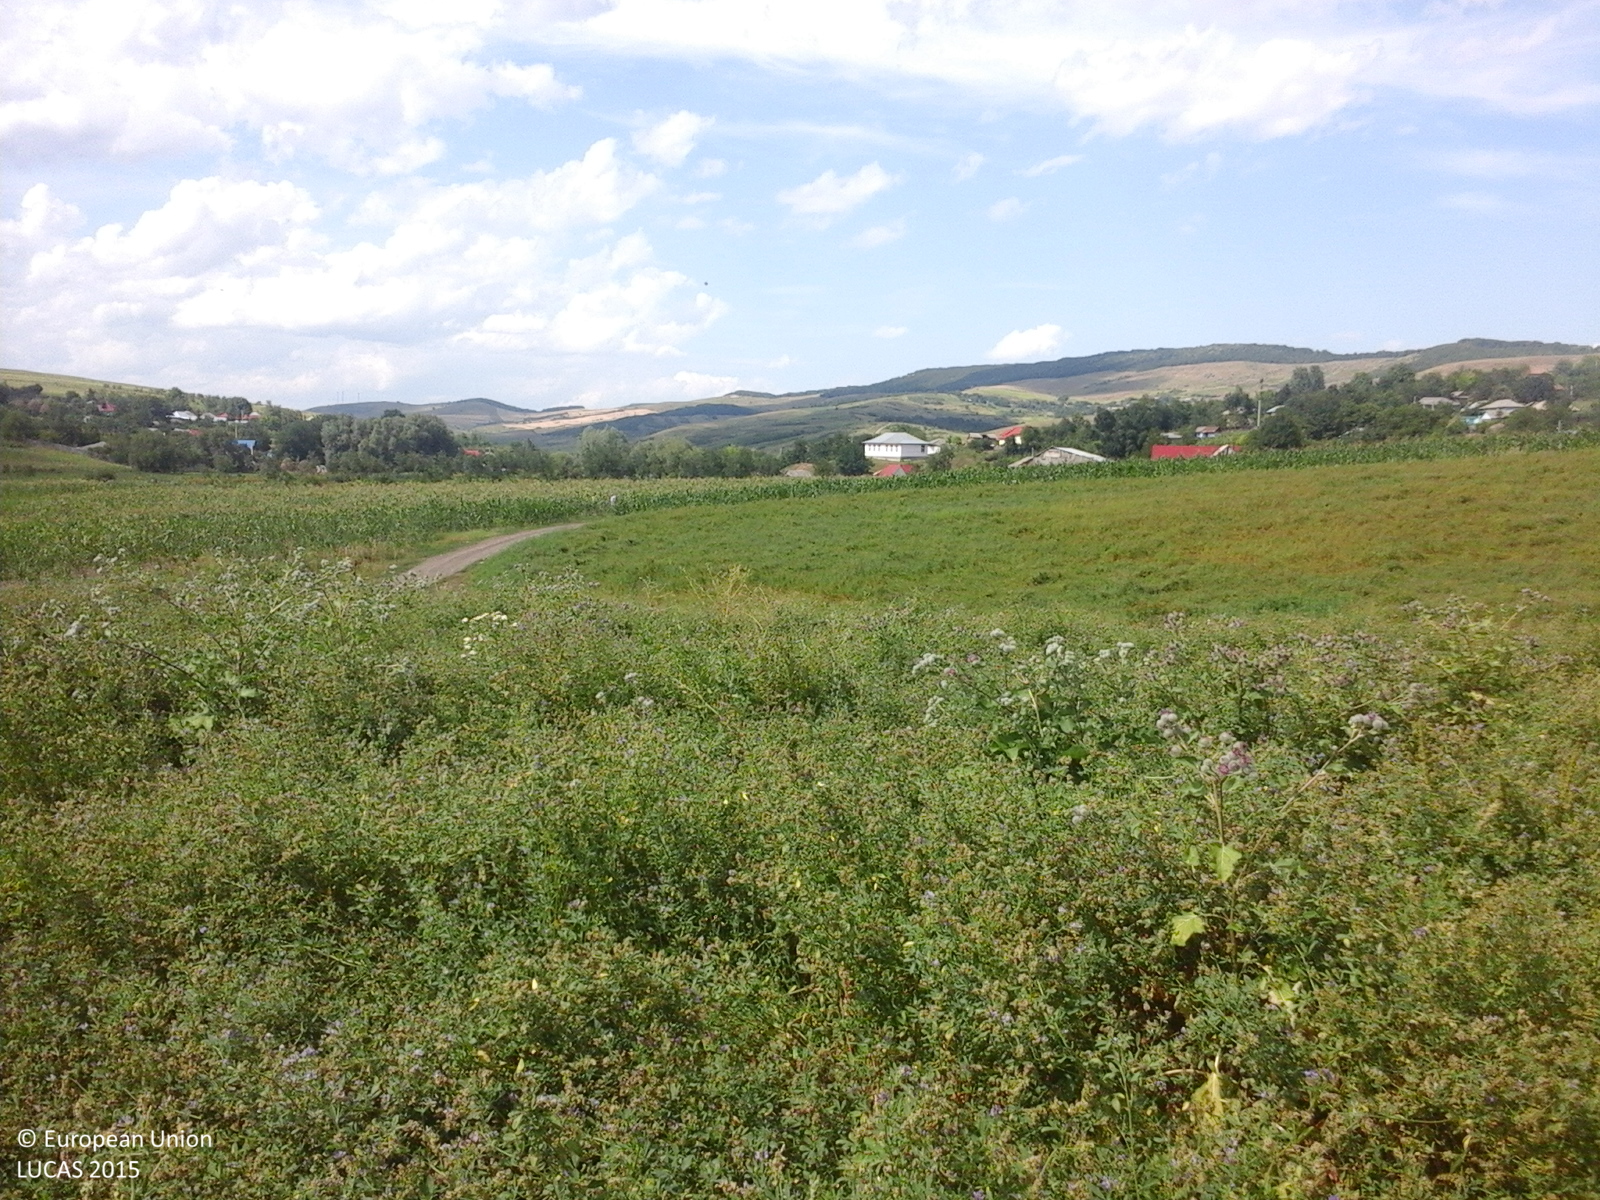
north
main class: Cropland
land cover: Lucerne
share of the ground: > 75 %
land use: Agriculture (excluding fallow land and kitchen gardens)
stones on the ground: < 10 %
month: July
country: RO
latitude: 46.5859
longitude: 27.4007
